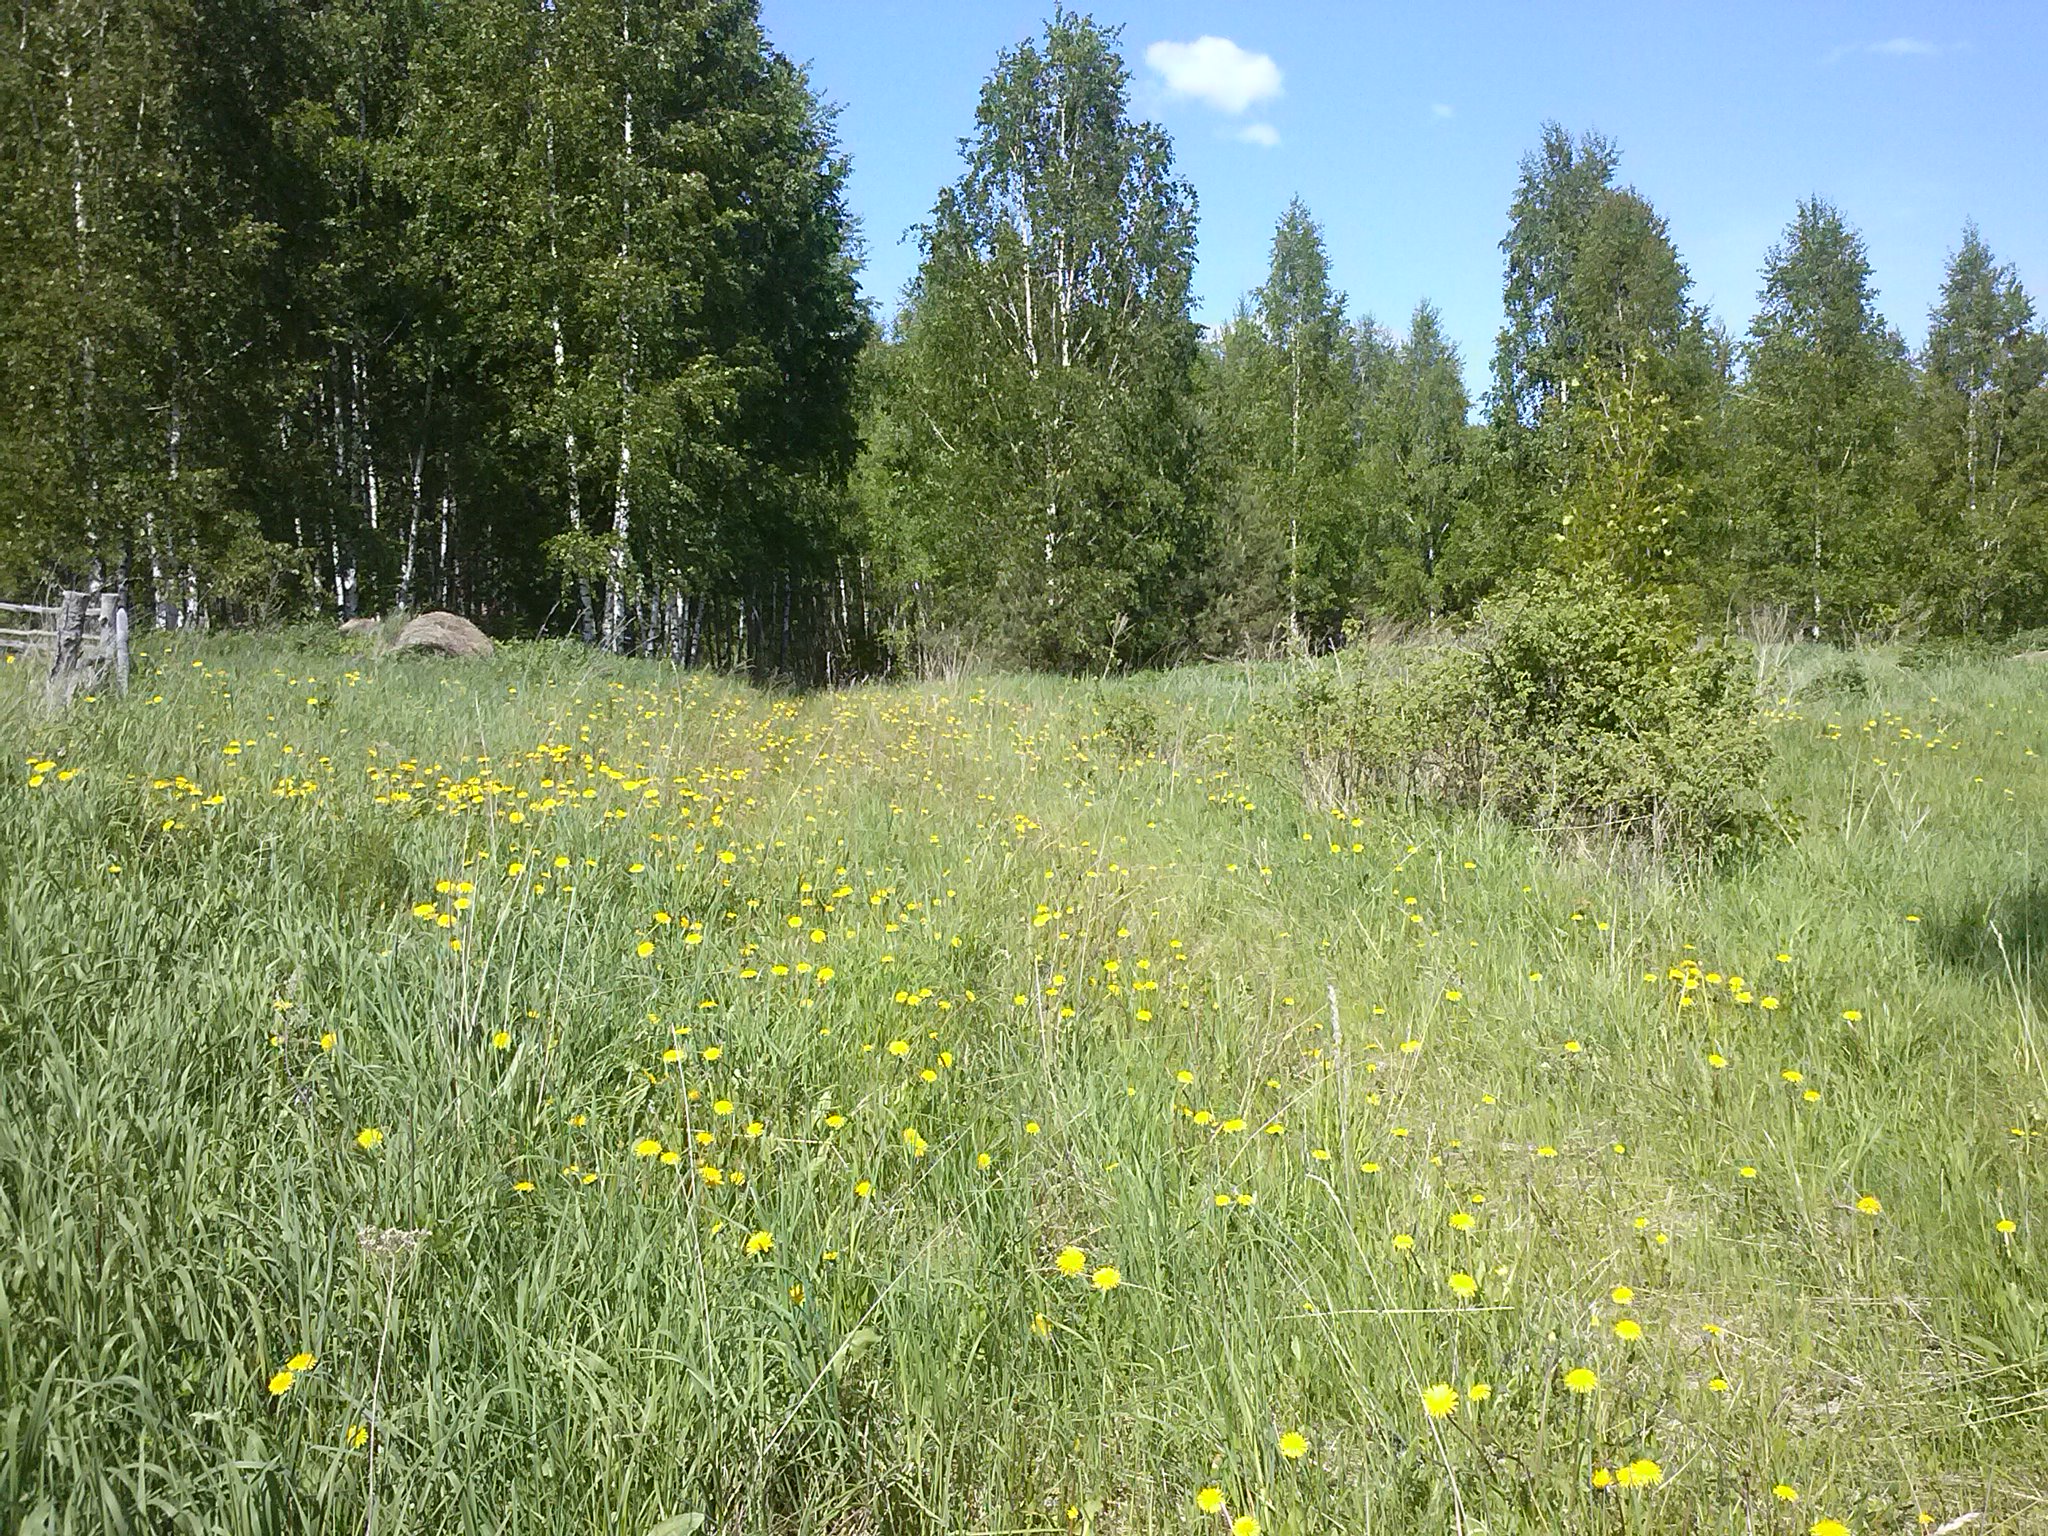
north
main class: Grassland
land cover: Grassland without tree/shrub cover
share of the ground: > 75 %
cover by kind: herbaceous plants 100 %
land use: Agriculture (excluding fallow land and kitchen gardens)
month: May
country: LV
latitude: 56.1969
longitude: 27.5733
